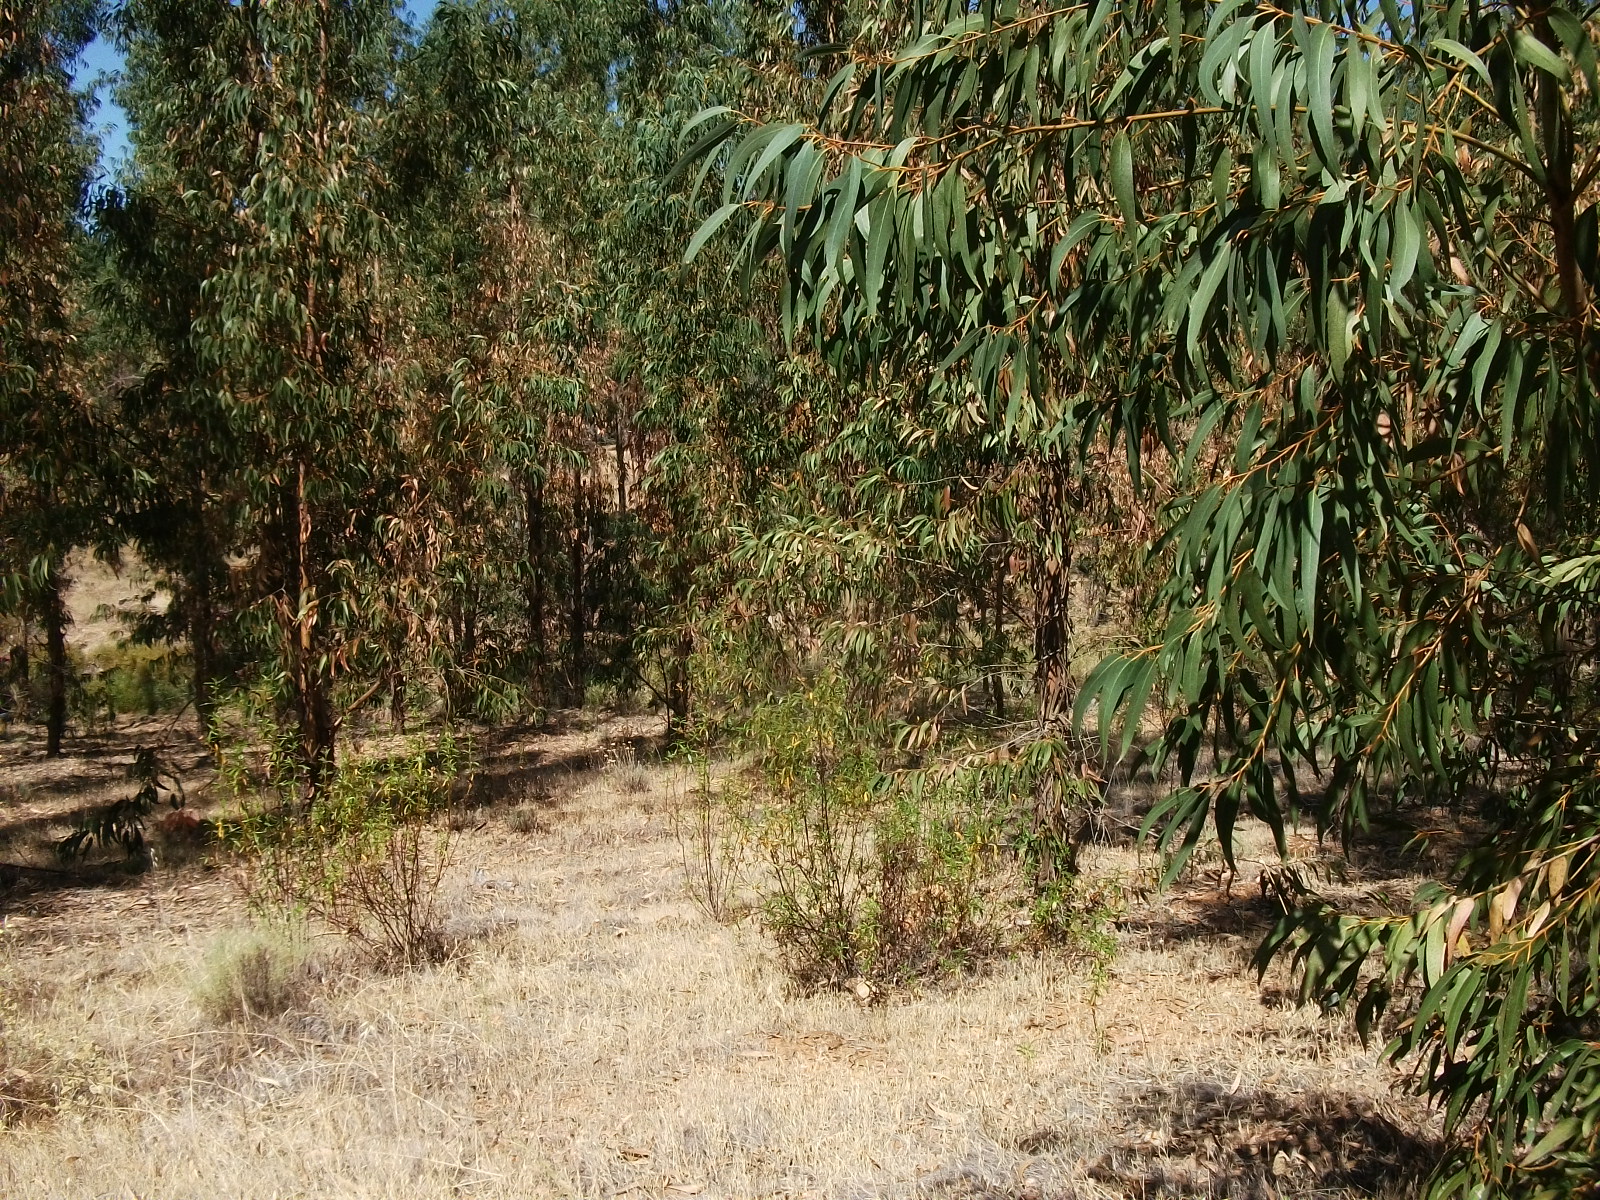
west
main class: Woodland
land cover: Broadleaved woodland
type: exotic forest
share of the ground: 50 - 75 %
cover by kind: broadleaved forest trees 70 %, herbaceous plants 20 %, shrubs 10 %
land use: Forestry
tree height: > 5 m
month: June
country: ES
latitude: 37.6513
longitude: -6.9689
